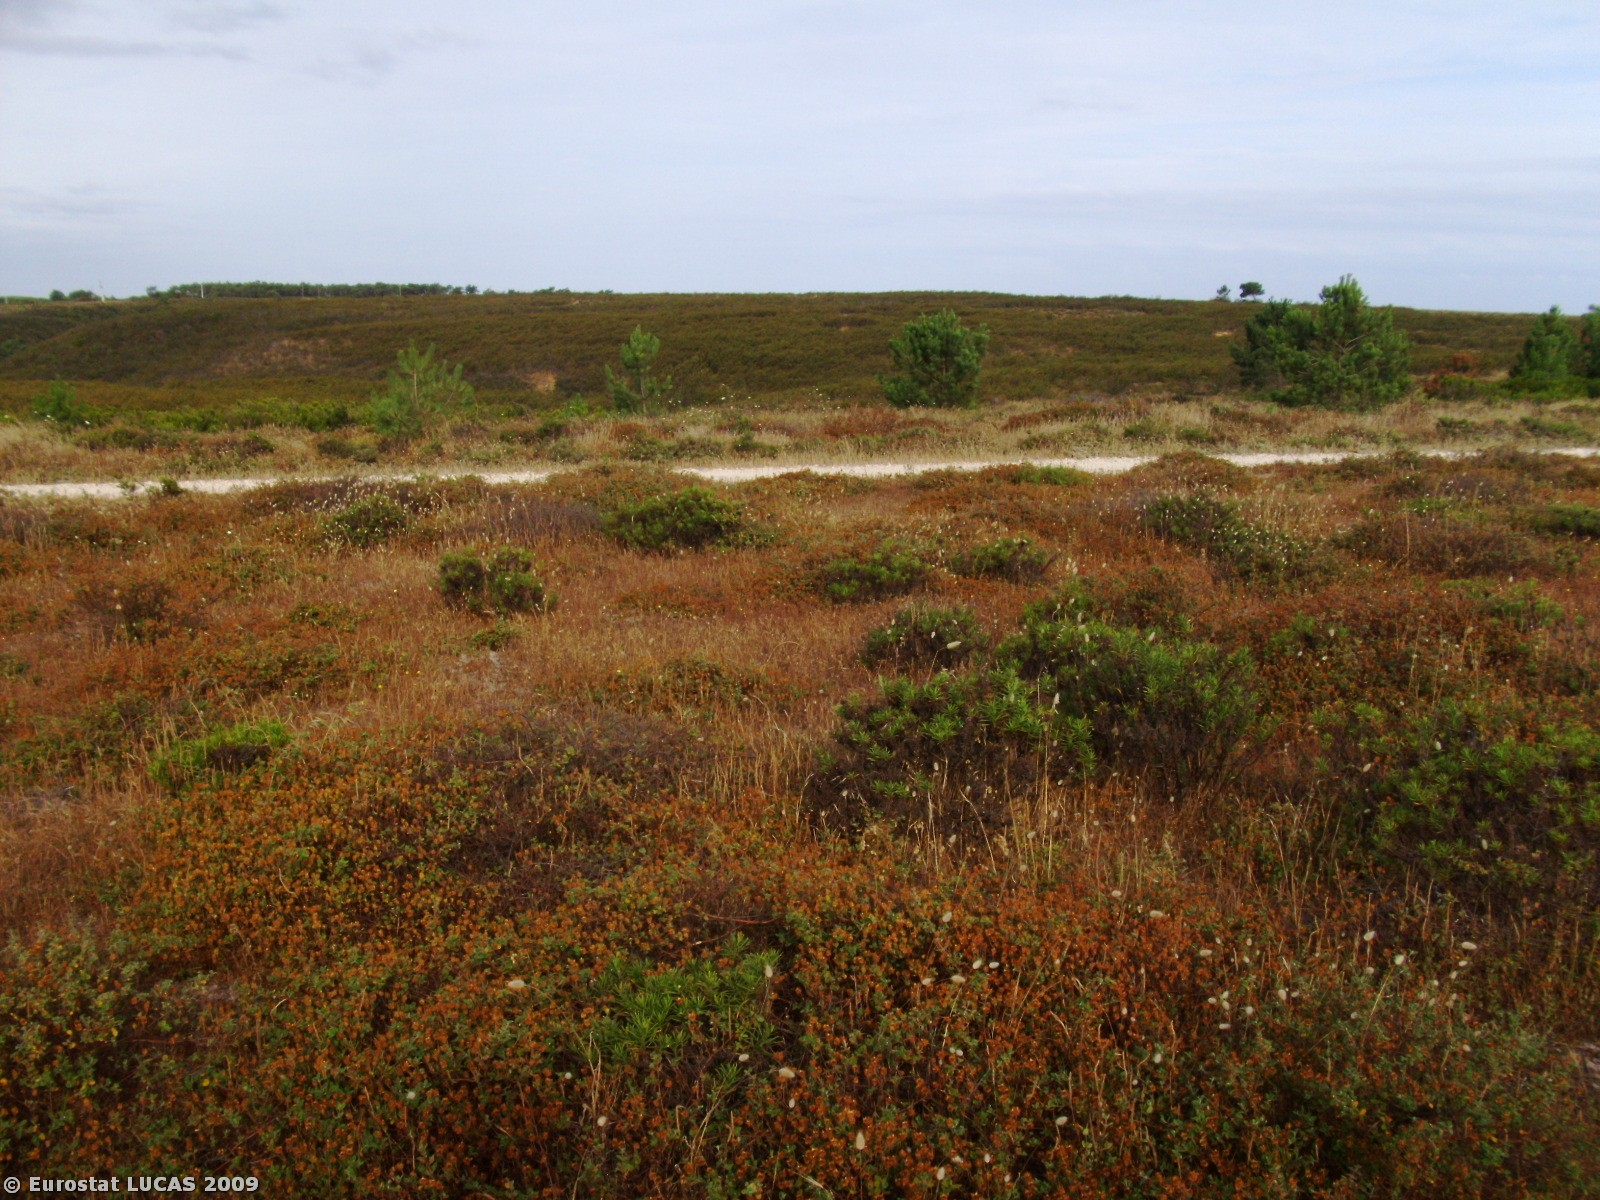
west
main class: Shrubland
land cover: Shrubland without tree cover
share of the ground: > 75 %
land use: Nature reserves
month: June
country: PT
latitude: 37.1125
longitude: -8.9065
